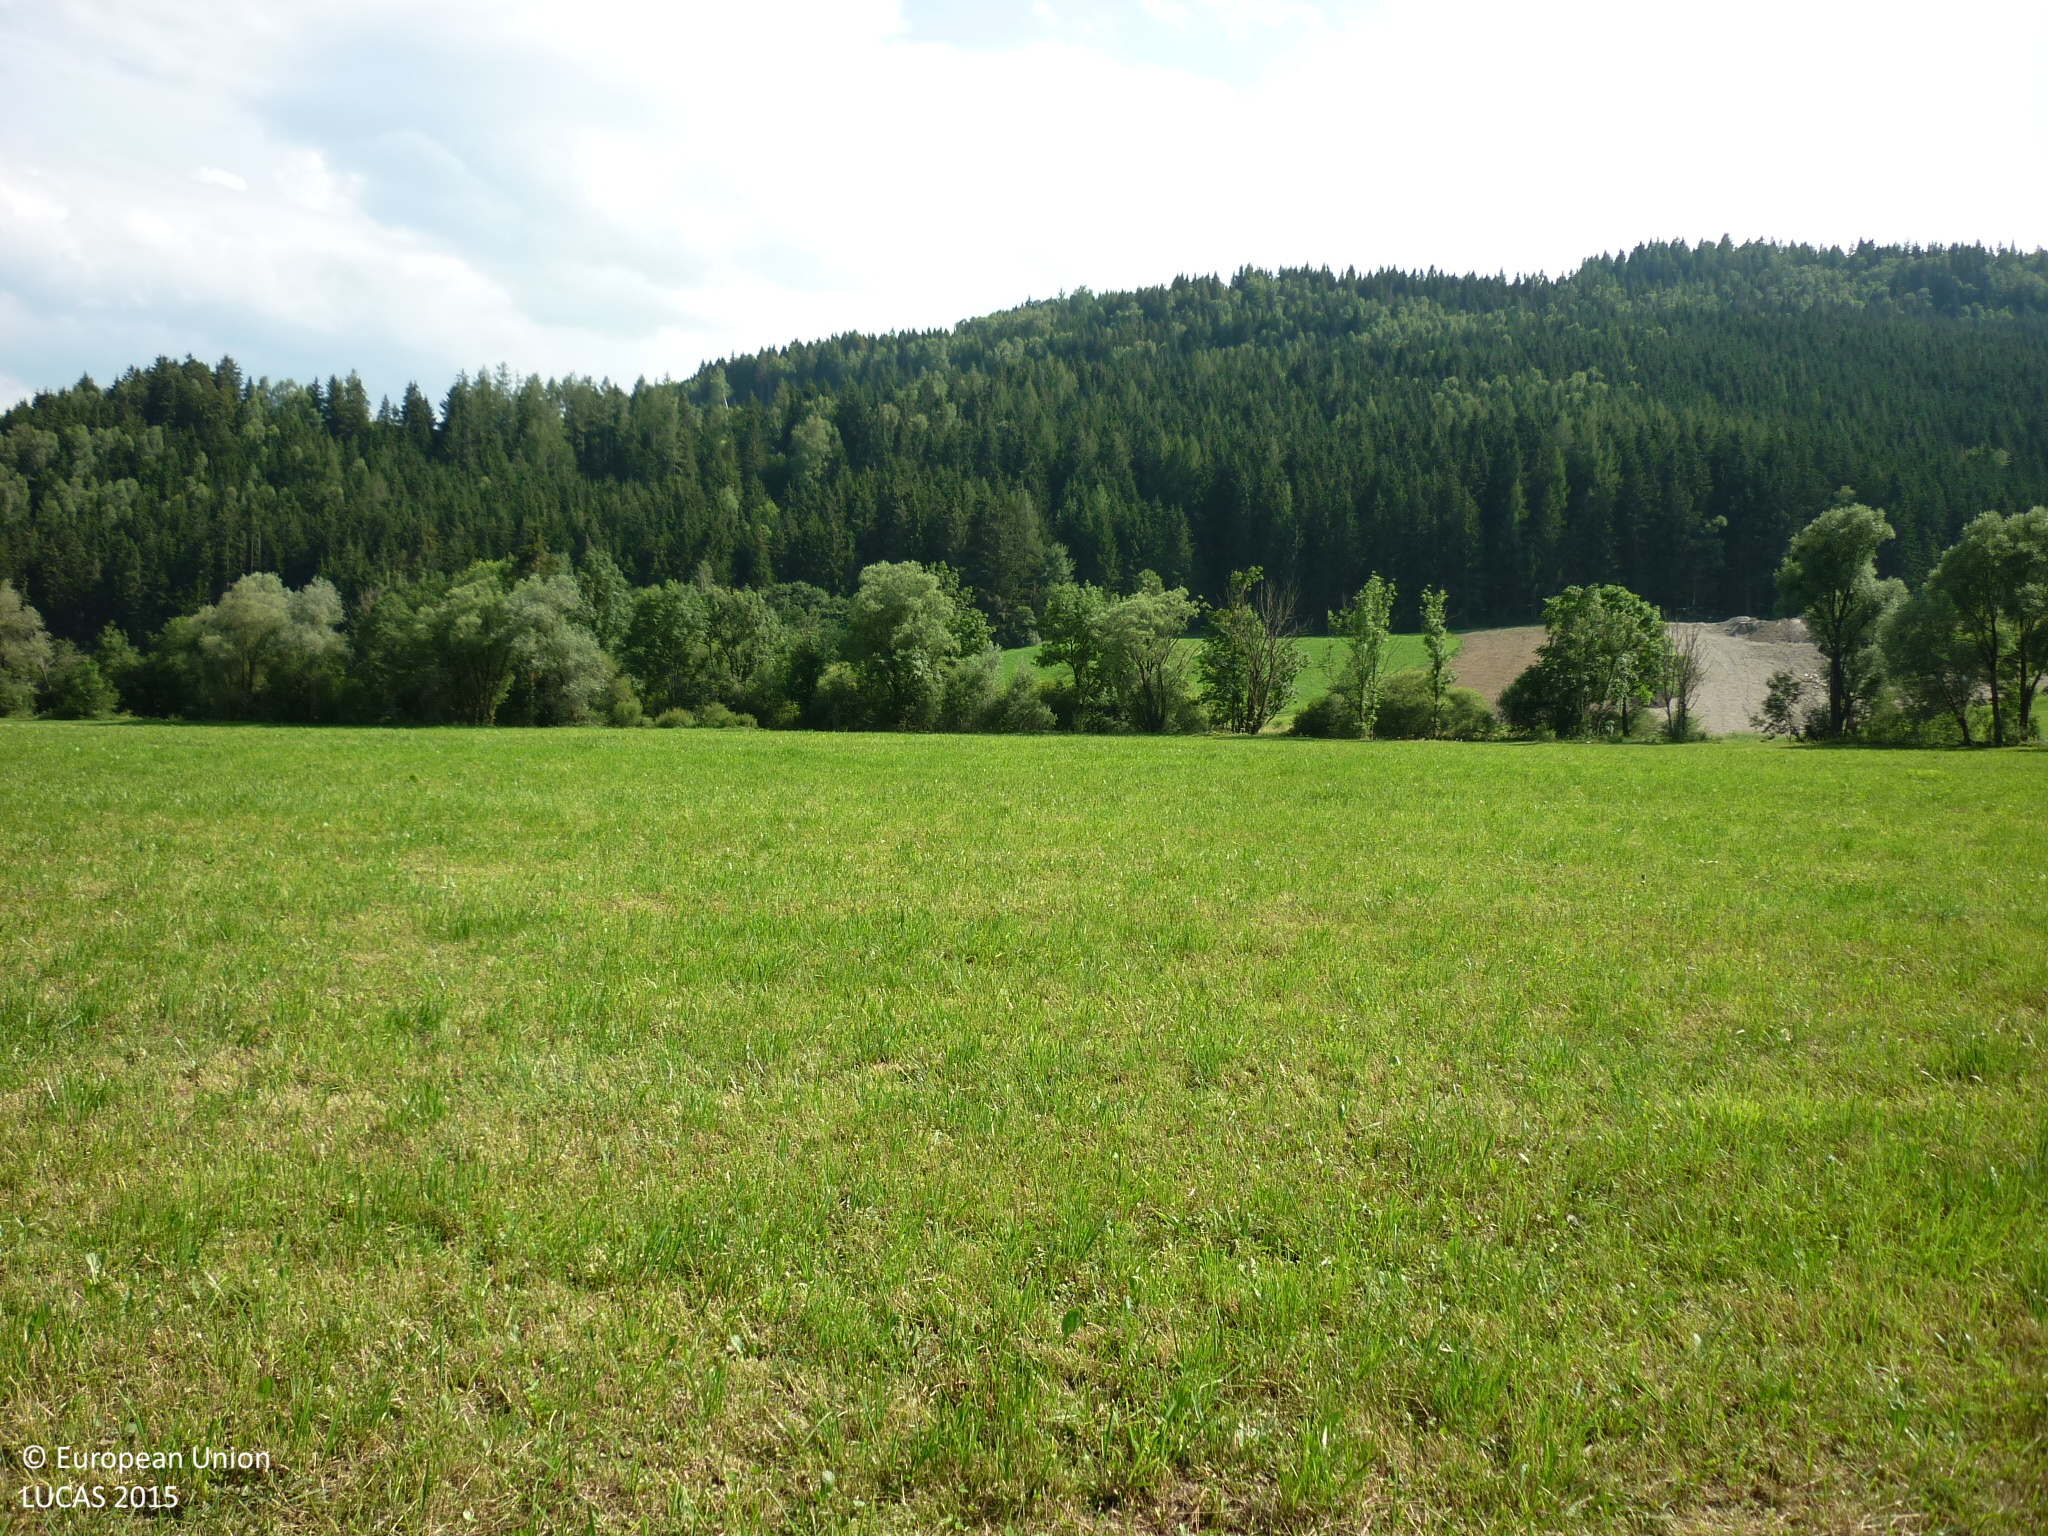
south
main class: Grassland
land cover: Grassland without tree/shrub cover
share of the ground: > 75 %
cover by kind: herbaceous plants 100 %
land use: Agriculture (excluding fallow land and kitchen gardens)
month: July
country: AT
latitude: 47.4845
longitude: 13.9933
